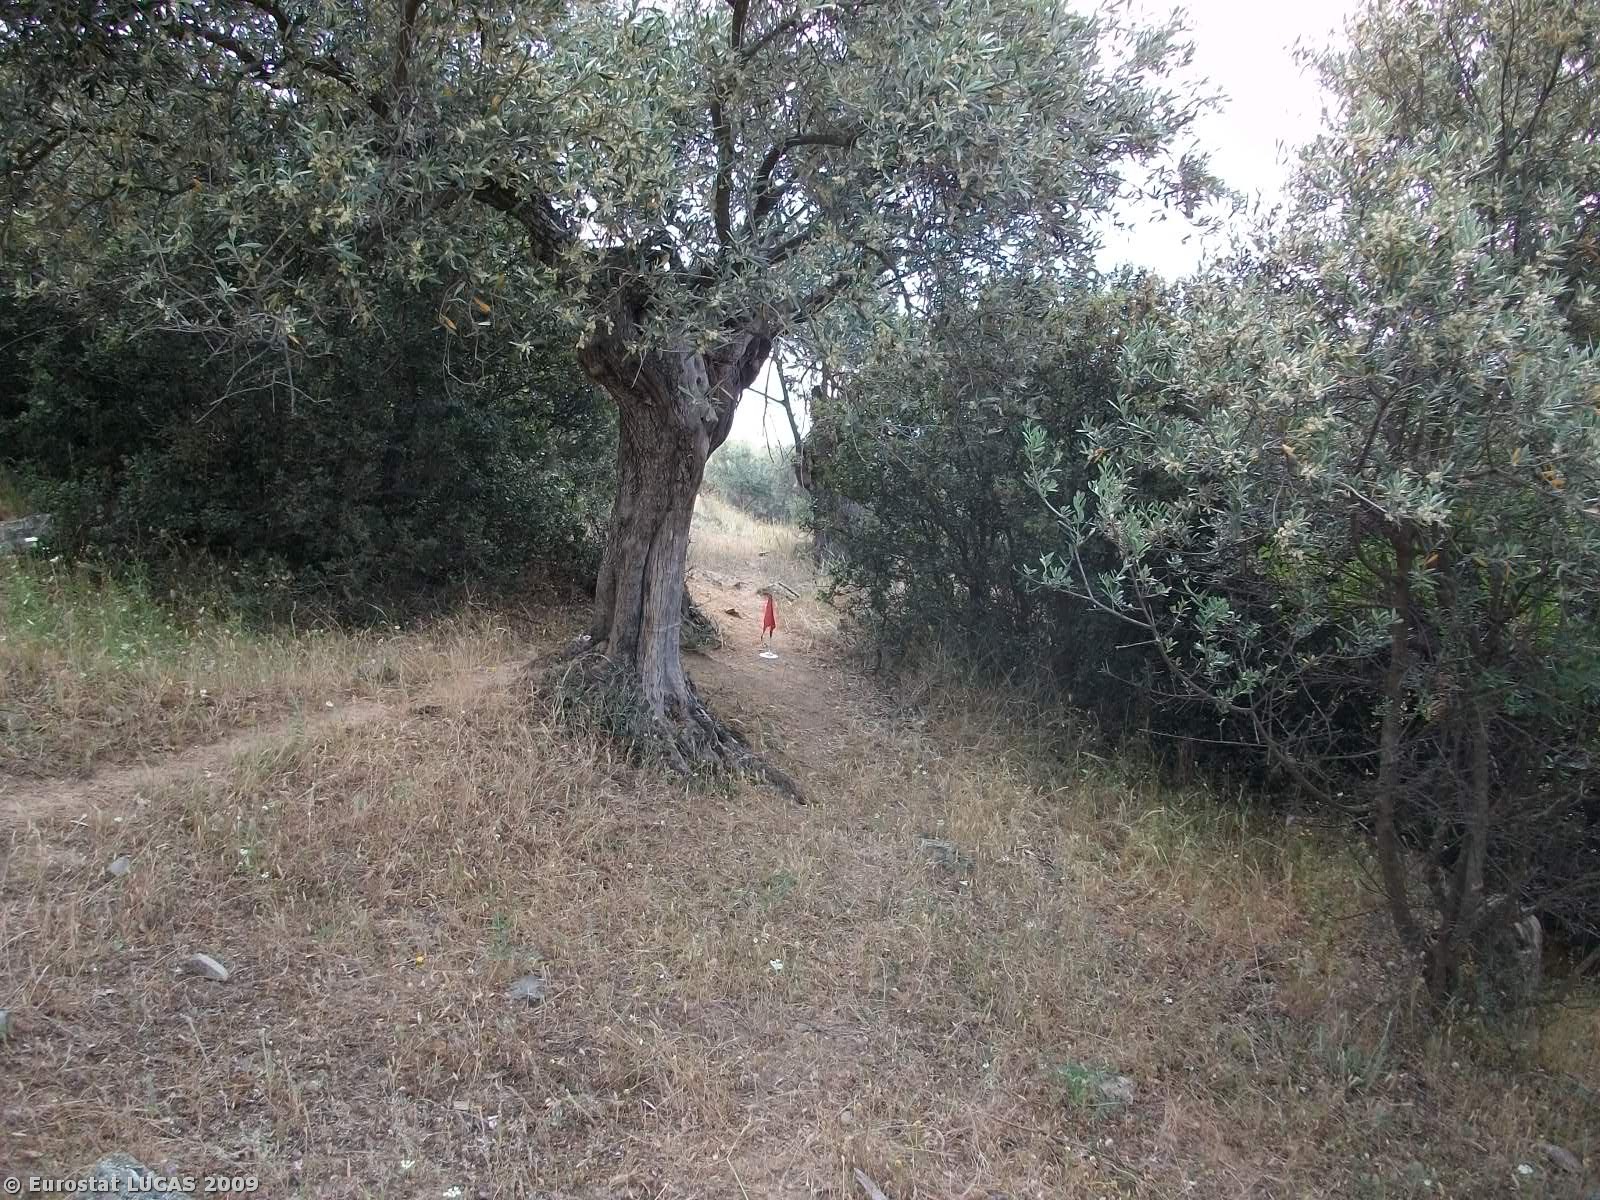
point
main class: Cropland
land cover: Olive groves
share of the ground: 25 - 50 %
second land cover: Grassland with sparse tree/shrub cover
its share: 50 - 75 %
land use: Agriculture (excluding fallow land and kitchen gardens)
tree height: < 5 m
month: May
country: GR
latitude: 39.8382
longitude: 22.4377
